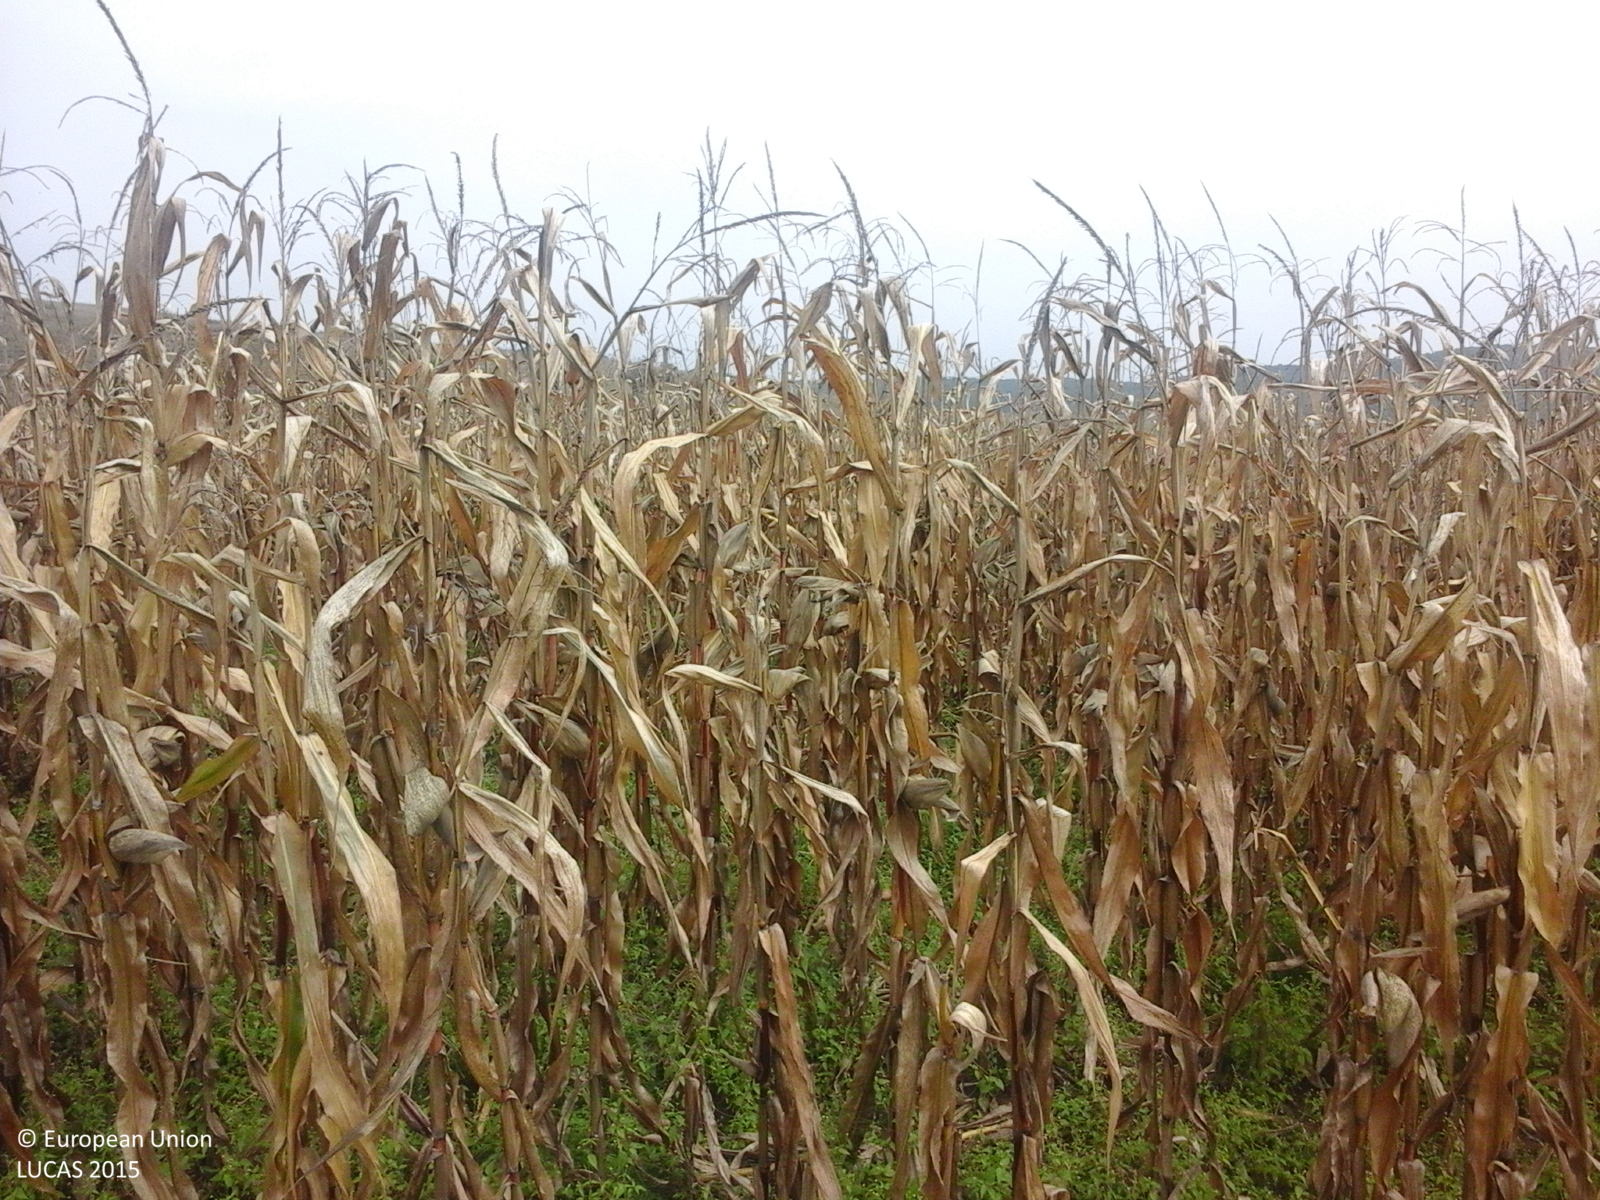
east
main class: Cropland
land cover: Common wheat
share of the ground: 25 - 50 %
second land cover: Spontaneously vegetated surfaces
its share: 50 - 75 %
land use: Agriculture (excluding fallow land and kitchen gardens)
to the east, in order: Common wheat; Spontaneously vegetated surfaces; Maize; Grassland without tree/shrub cover; Paved roads, cycling and walking lanes; Spontaneously vegetated surfaces; Other bare soil; Grassland without tree/shrub cover; Lucerne; Grassland without tree/shrub cover
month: October
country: RO
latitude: 45.9734
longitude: 25.1850
